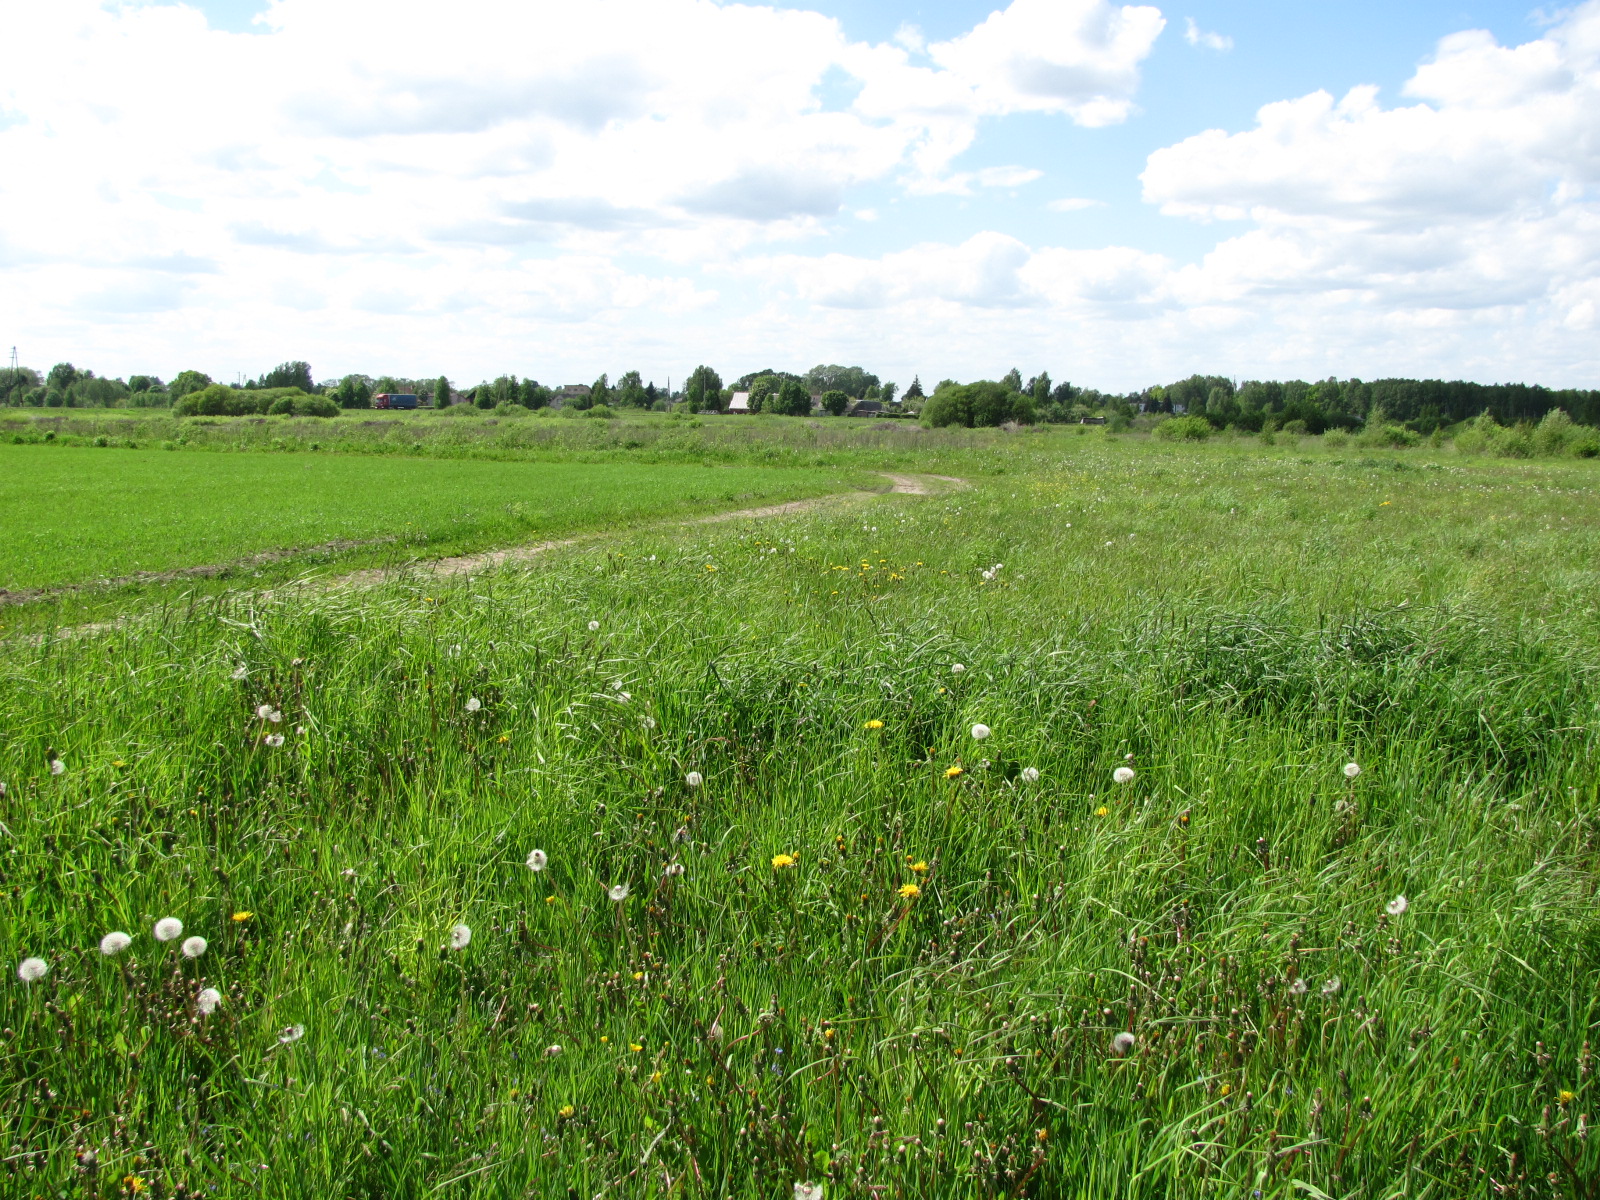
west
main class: Grassland
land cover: Grassland without tree/shrub cover
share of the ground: > 75 %
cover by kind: herbaceous plants 100 %
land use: Agriculture (excluding fallow land and kitchen gardens)
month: May
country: LV
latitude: 56.6267
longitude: 23.9547
